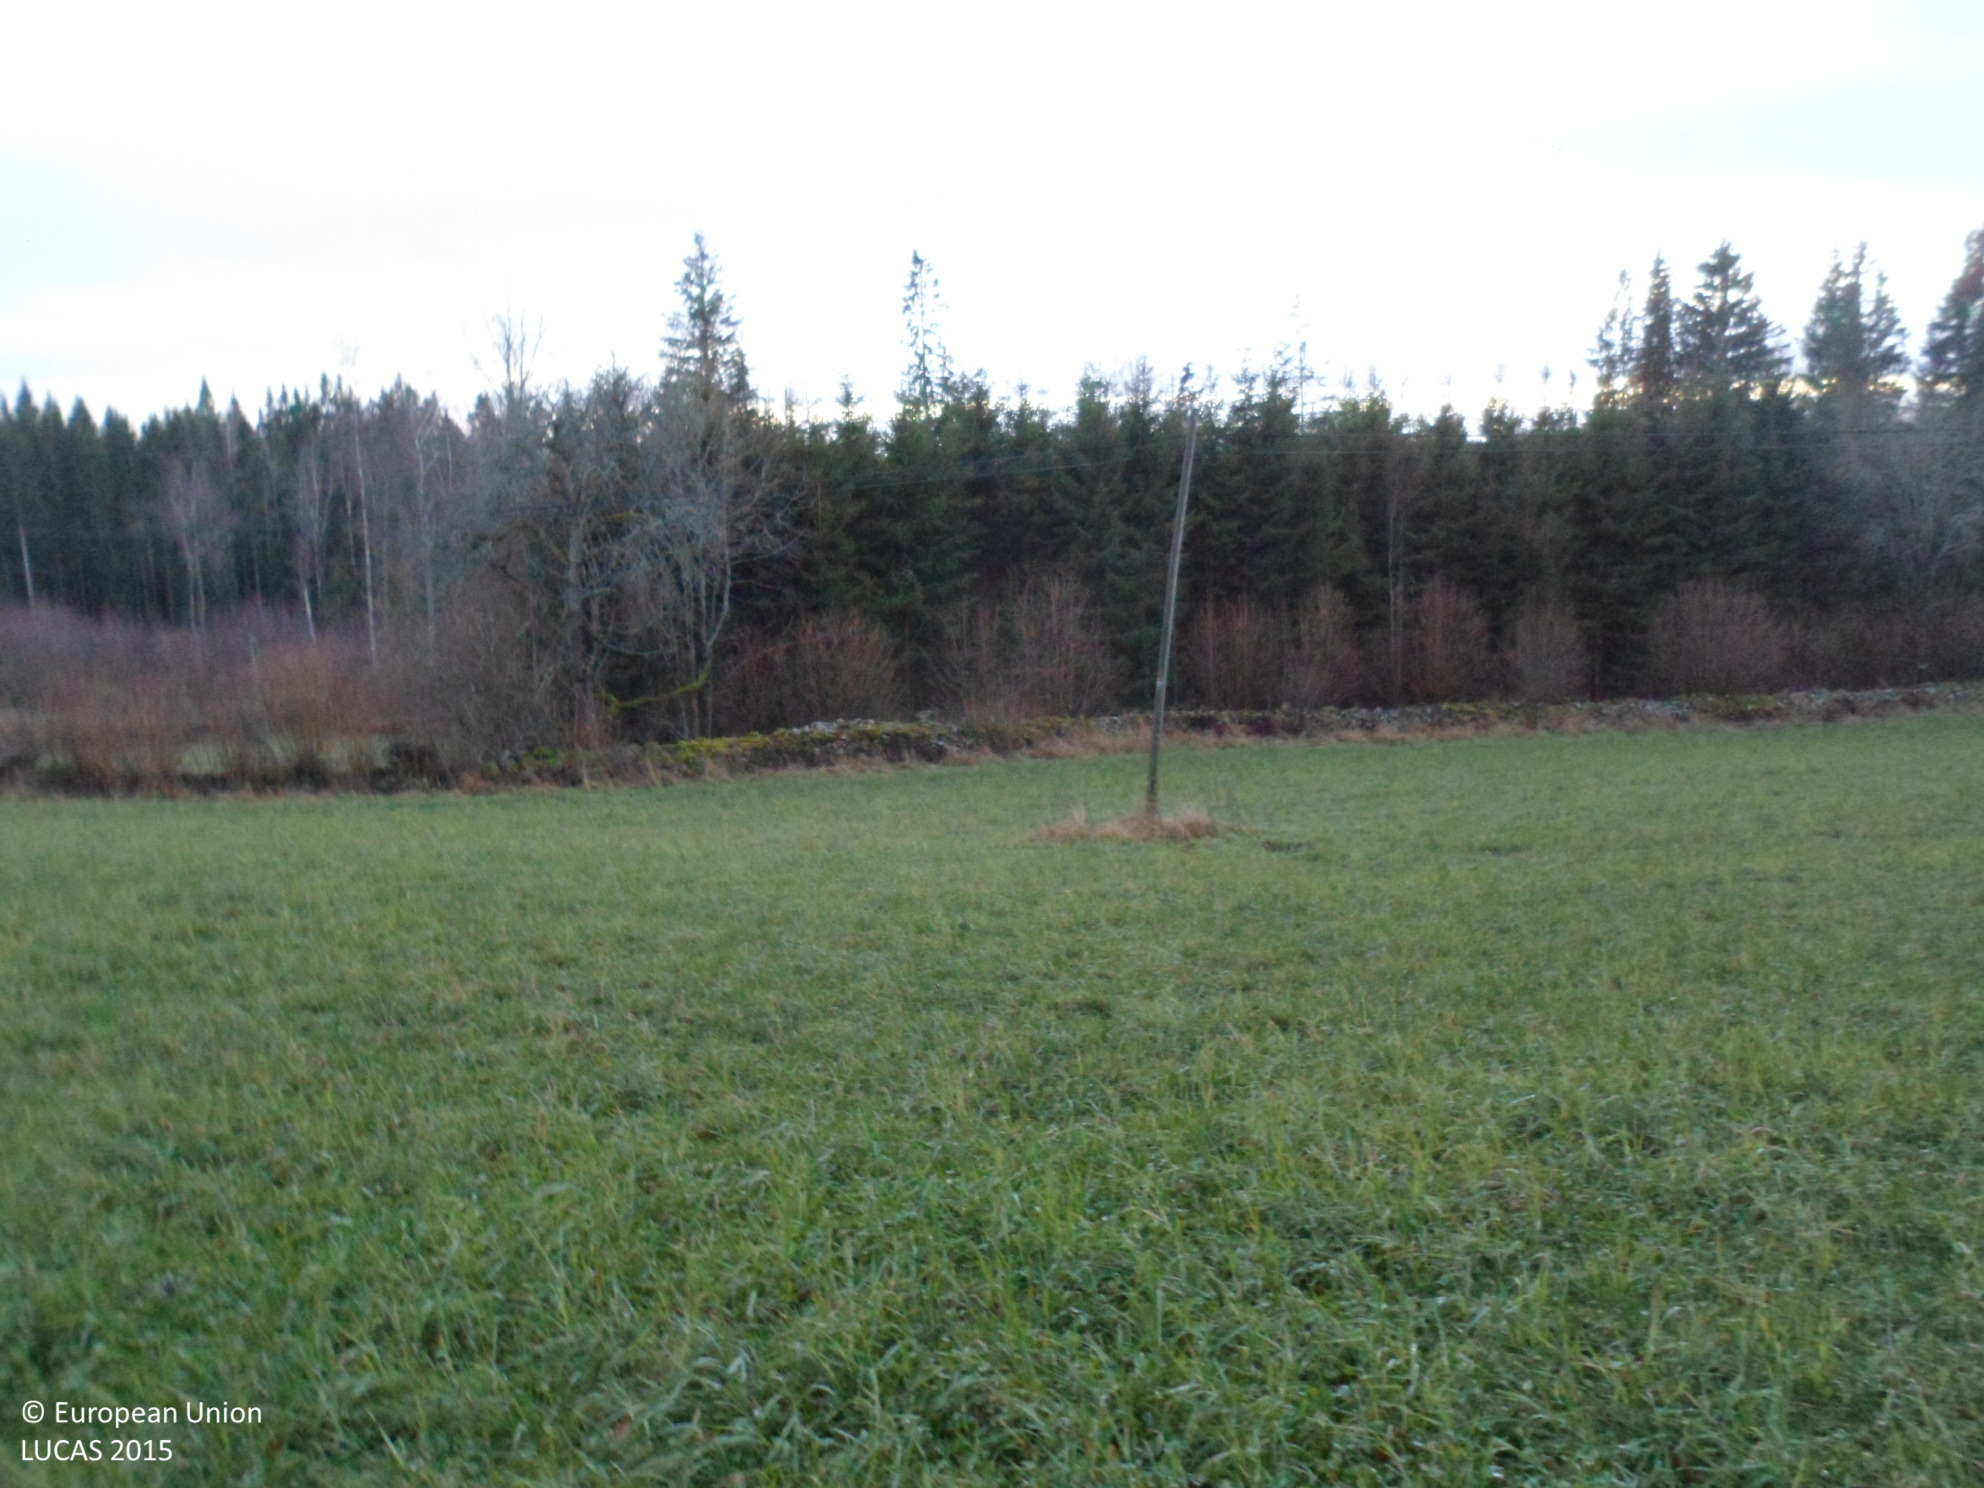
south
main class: Grassland
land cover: Grassland without tree/shrub cover
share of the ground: > 75 %
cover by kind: herbaceous plants 100 %
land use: Agriculture (excluding fallow land and kitchen gardens)
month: November
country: SE
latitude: 57.5949
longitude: 15.2328
